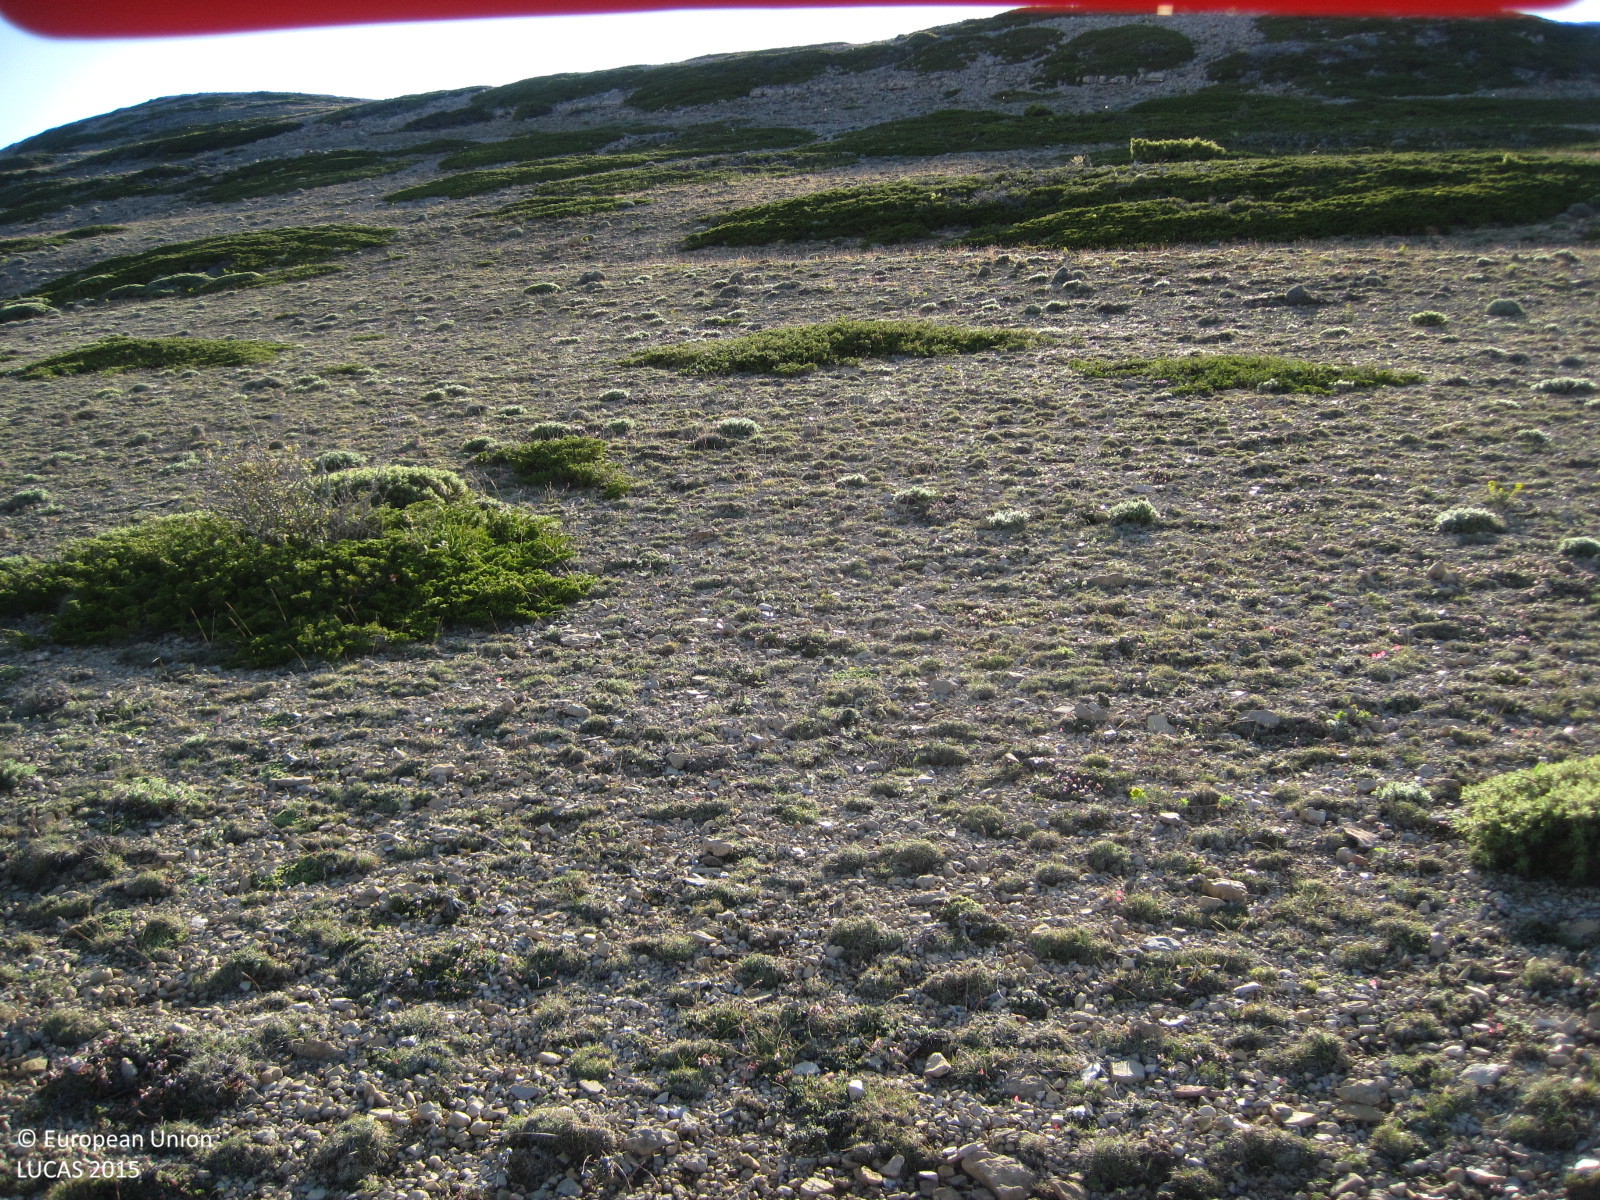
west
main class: Grassland
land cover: Grassland without tree/shrub cover
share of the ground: 50 - 75 %
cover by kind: herbaceous plants 50 %, consolidated bare surface 45 %, shrubs 5 %
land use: Semi-natural and natural areas not in use
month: June
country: ES
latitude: 40.0646
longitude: -1.0162
